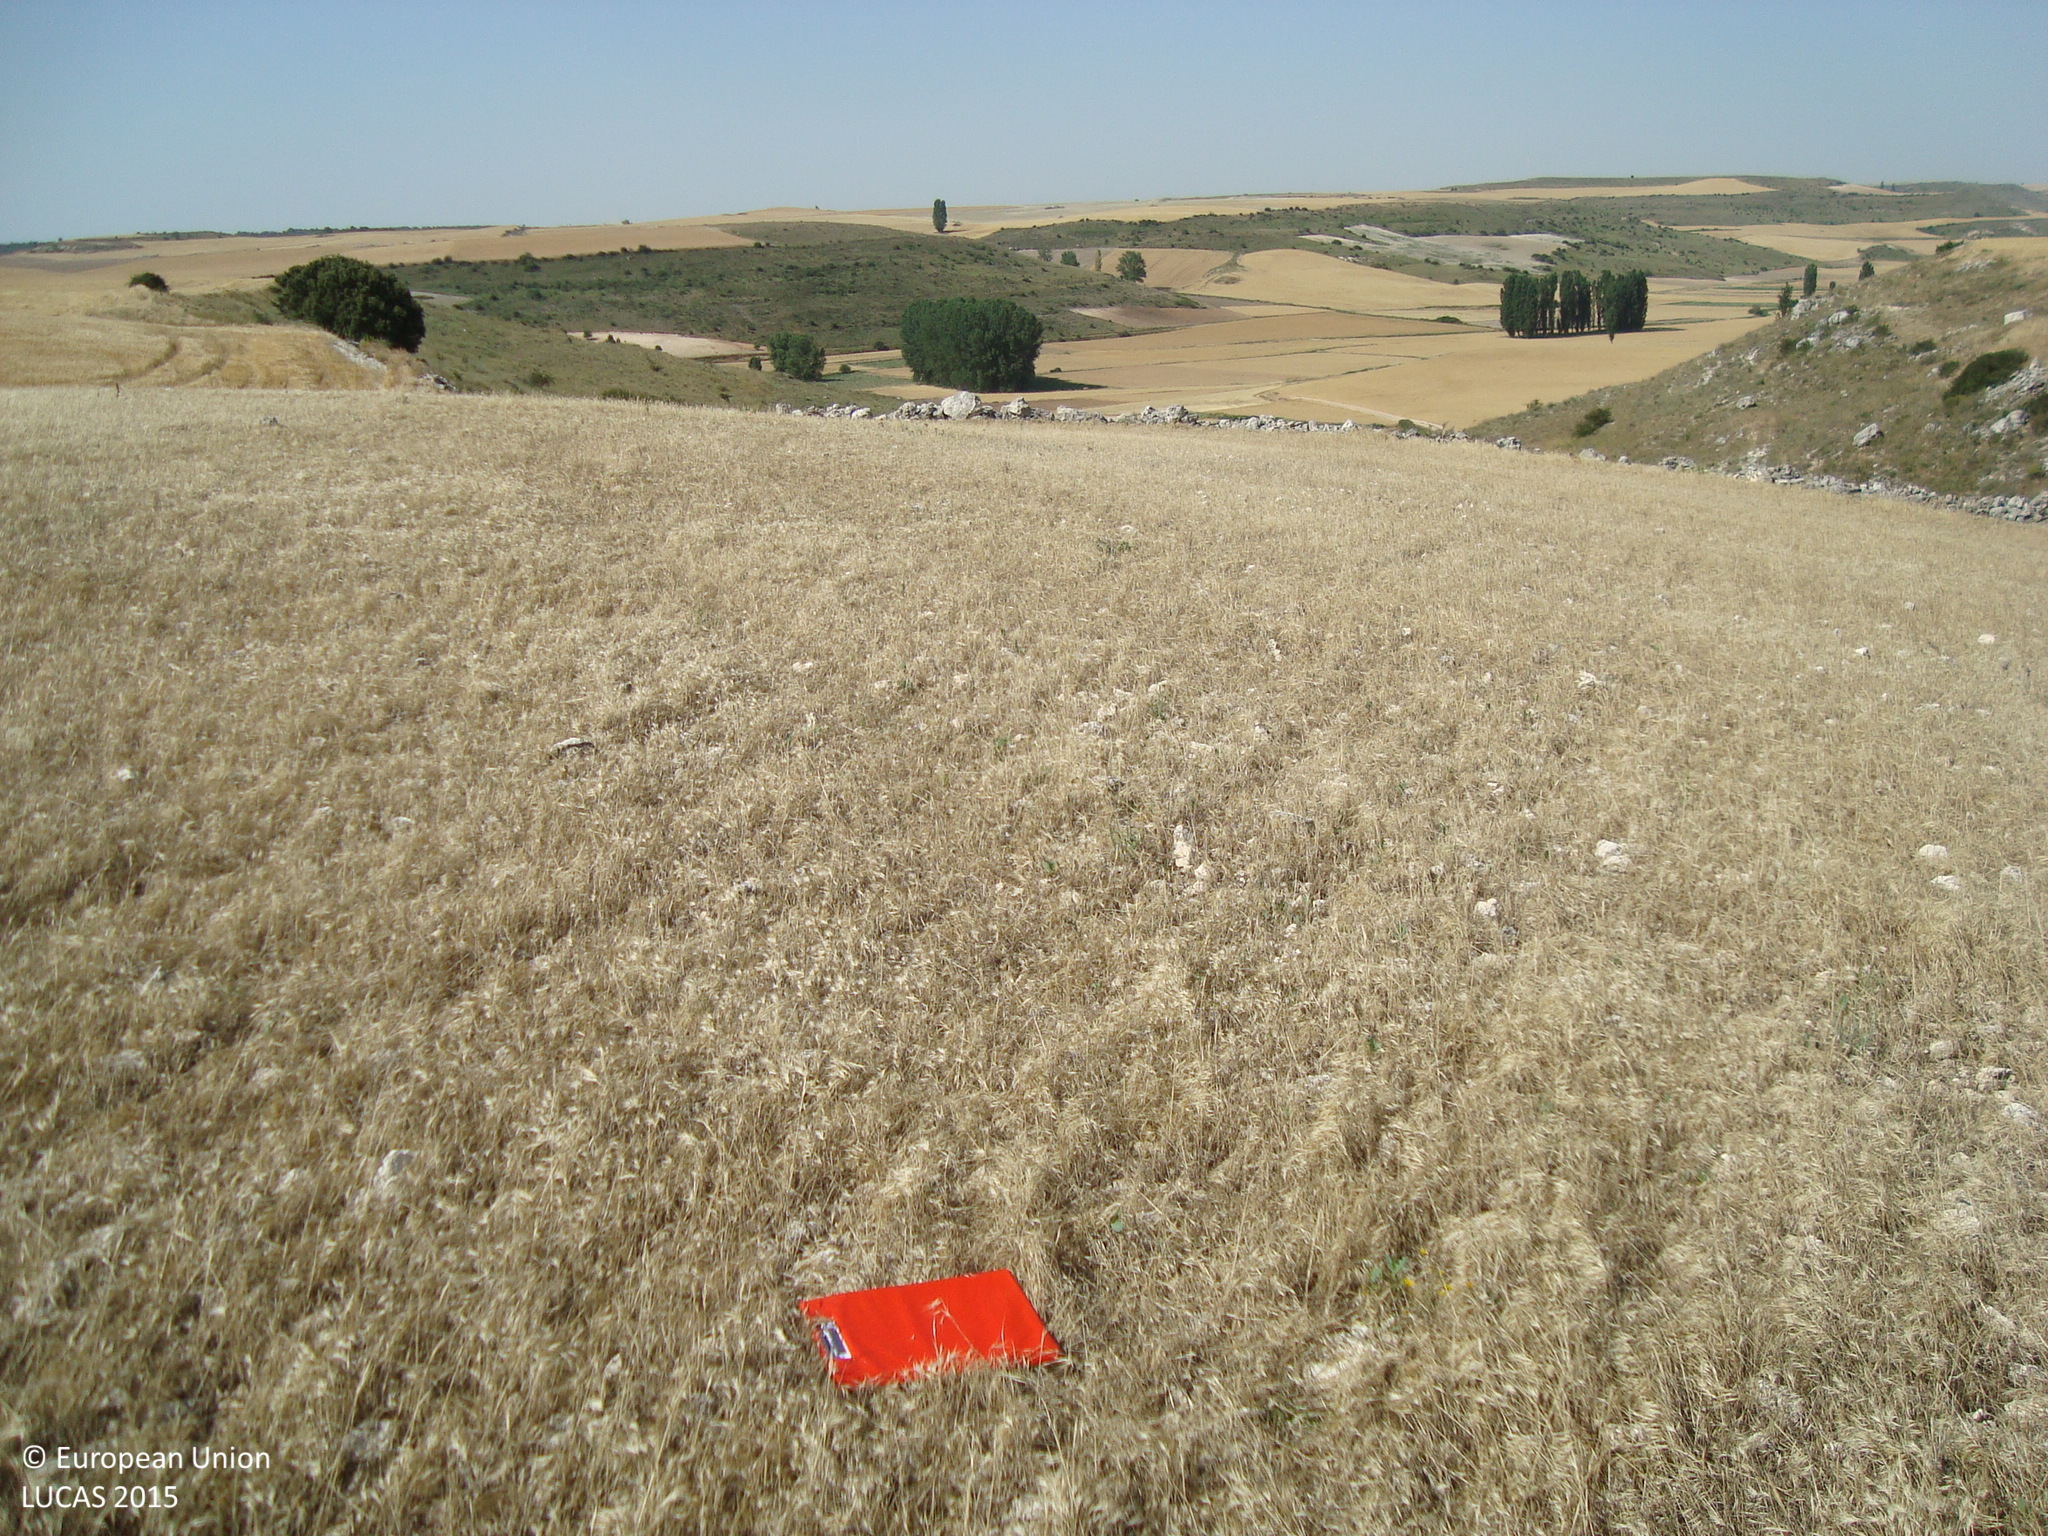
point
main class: Grassland
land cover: Grassland without tree/shrub cover
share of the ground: > 75 %
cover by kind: herbaceous plants 90 %, unconsolidated bare surface 10 %
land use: Abandoned areas
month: July
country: ES
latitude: 41.8409
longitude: -3.8706
